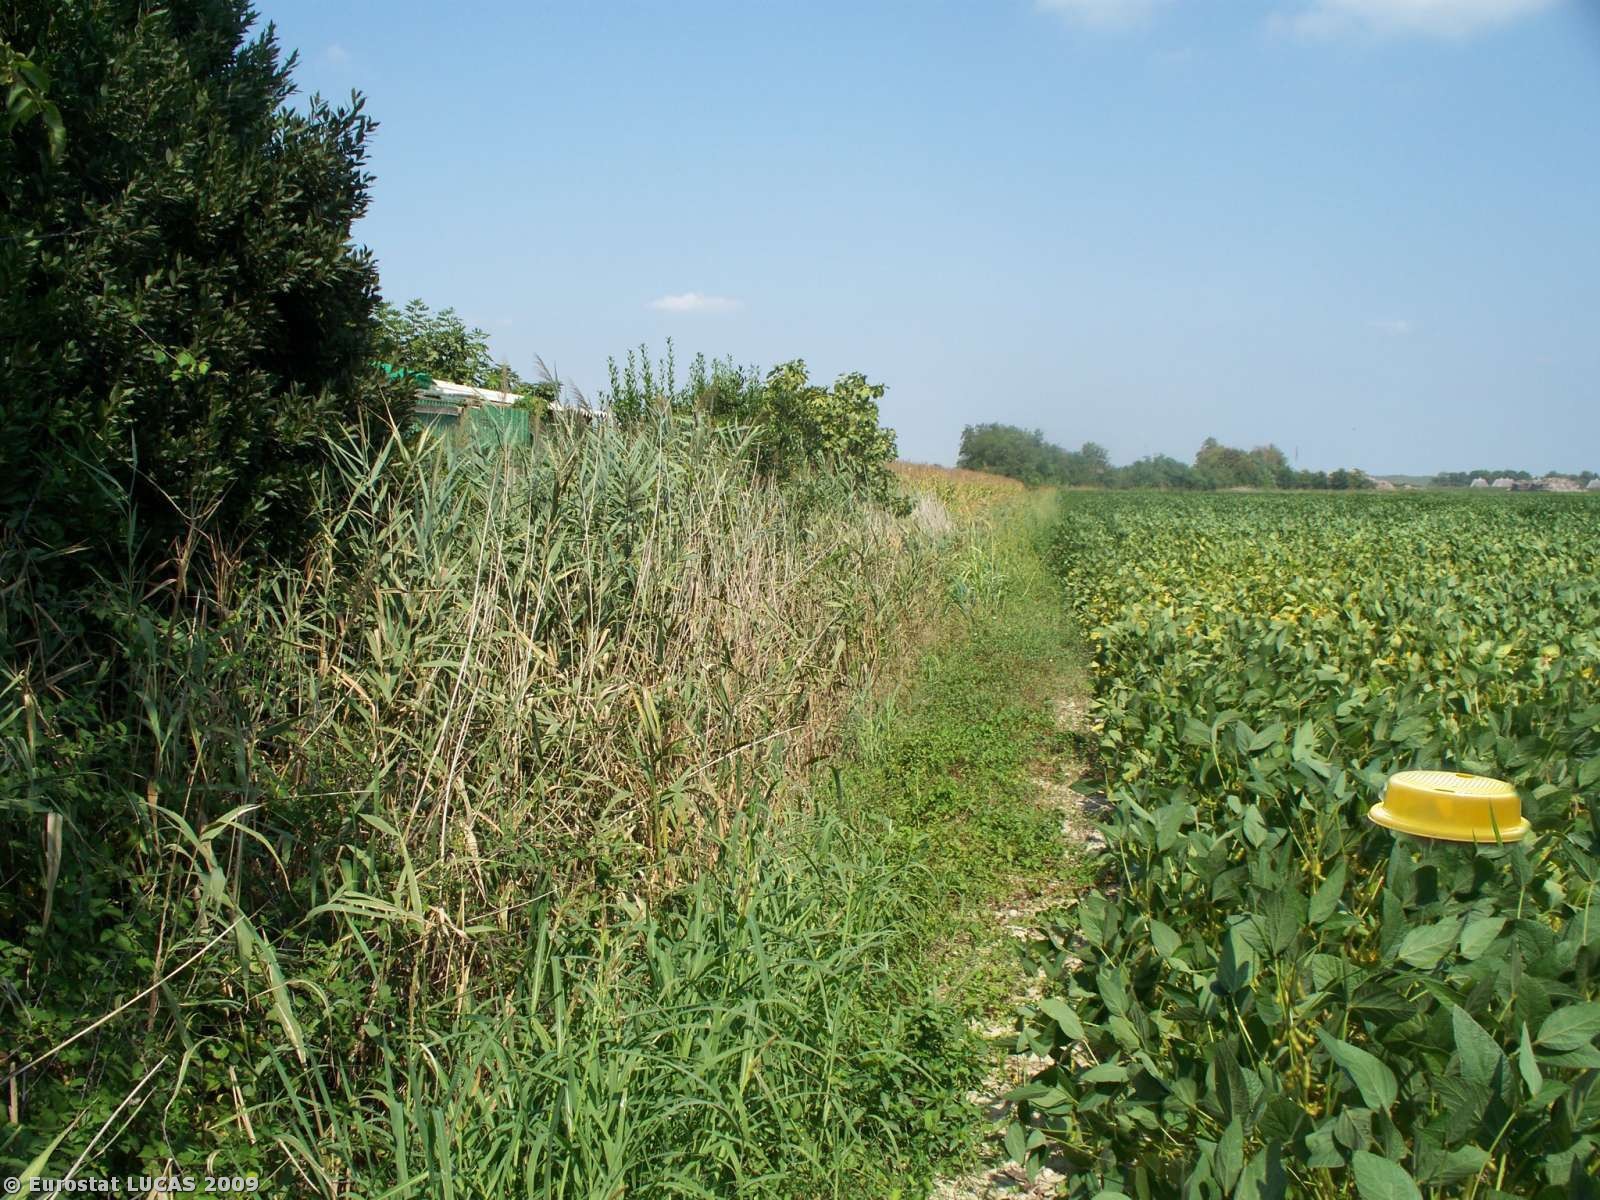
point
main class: Cropland
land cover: Soya
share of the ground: > 75 %
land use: Agriculture (excluding fallow land and kitchen gardens)
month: May
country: IT
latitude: 45.6613
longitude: 12.9607
